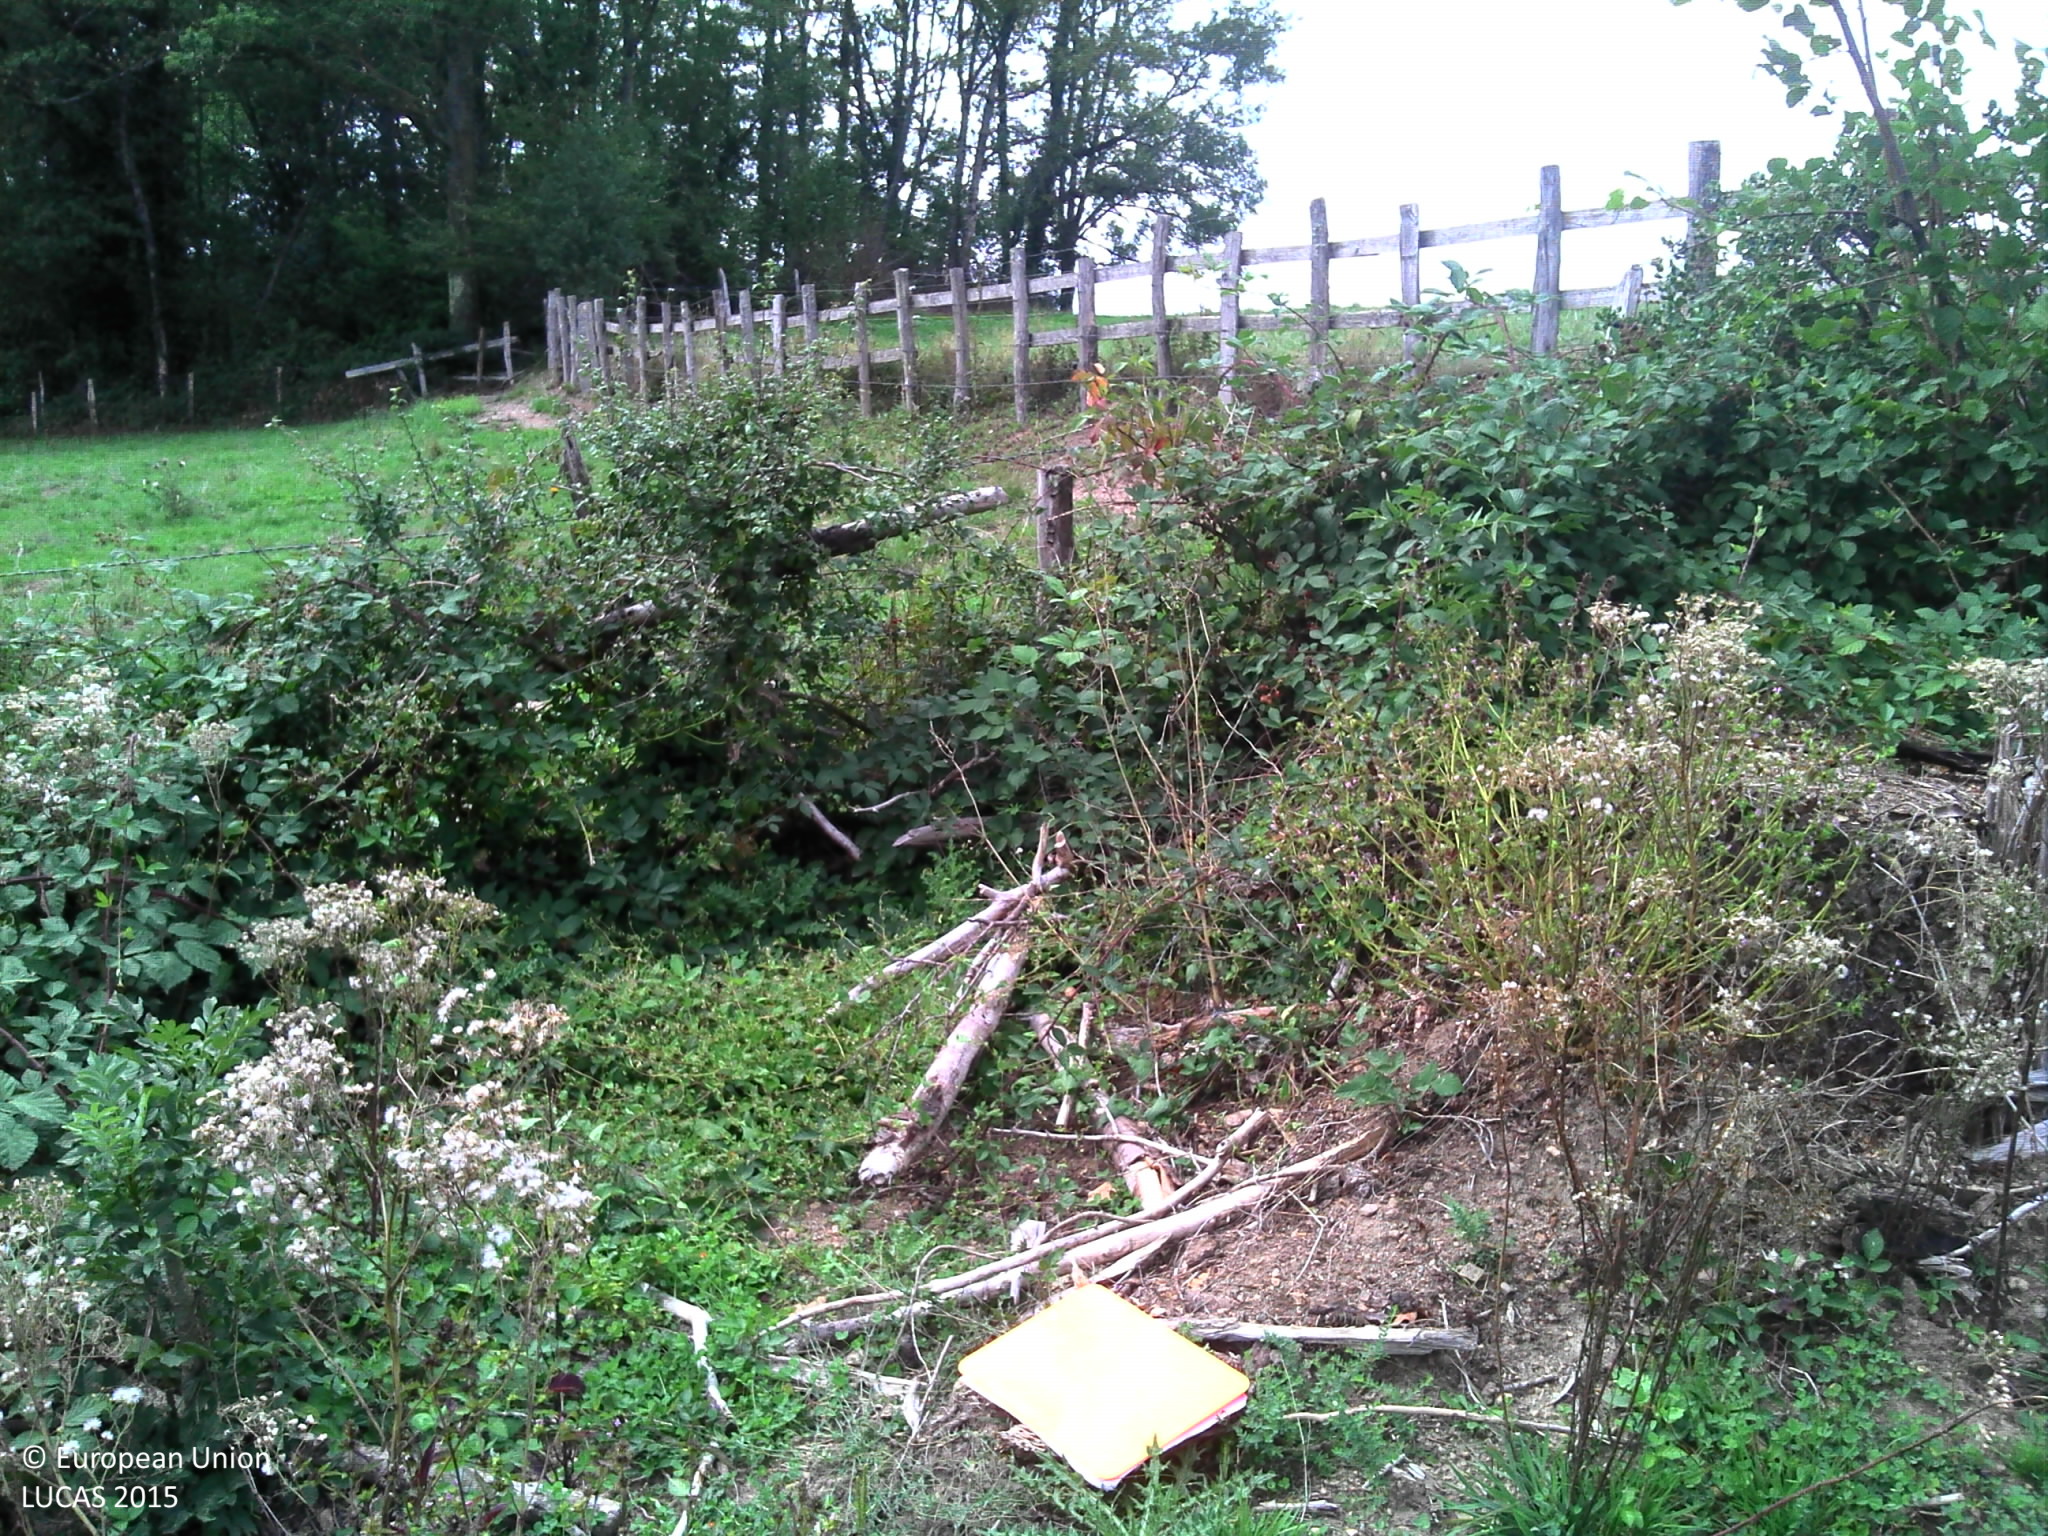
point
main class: Shrubland
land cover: Shrubland without tree cover
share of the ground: > 75 %
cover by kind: shrubs 60 %, herbaceous plants 30 %, consolidated bare surface 10 %
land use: Forestry
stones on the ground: 25 - 50 %
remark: Clear cut
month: August
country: FR
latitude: 46.2413
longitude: 4.4122
